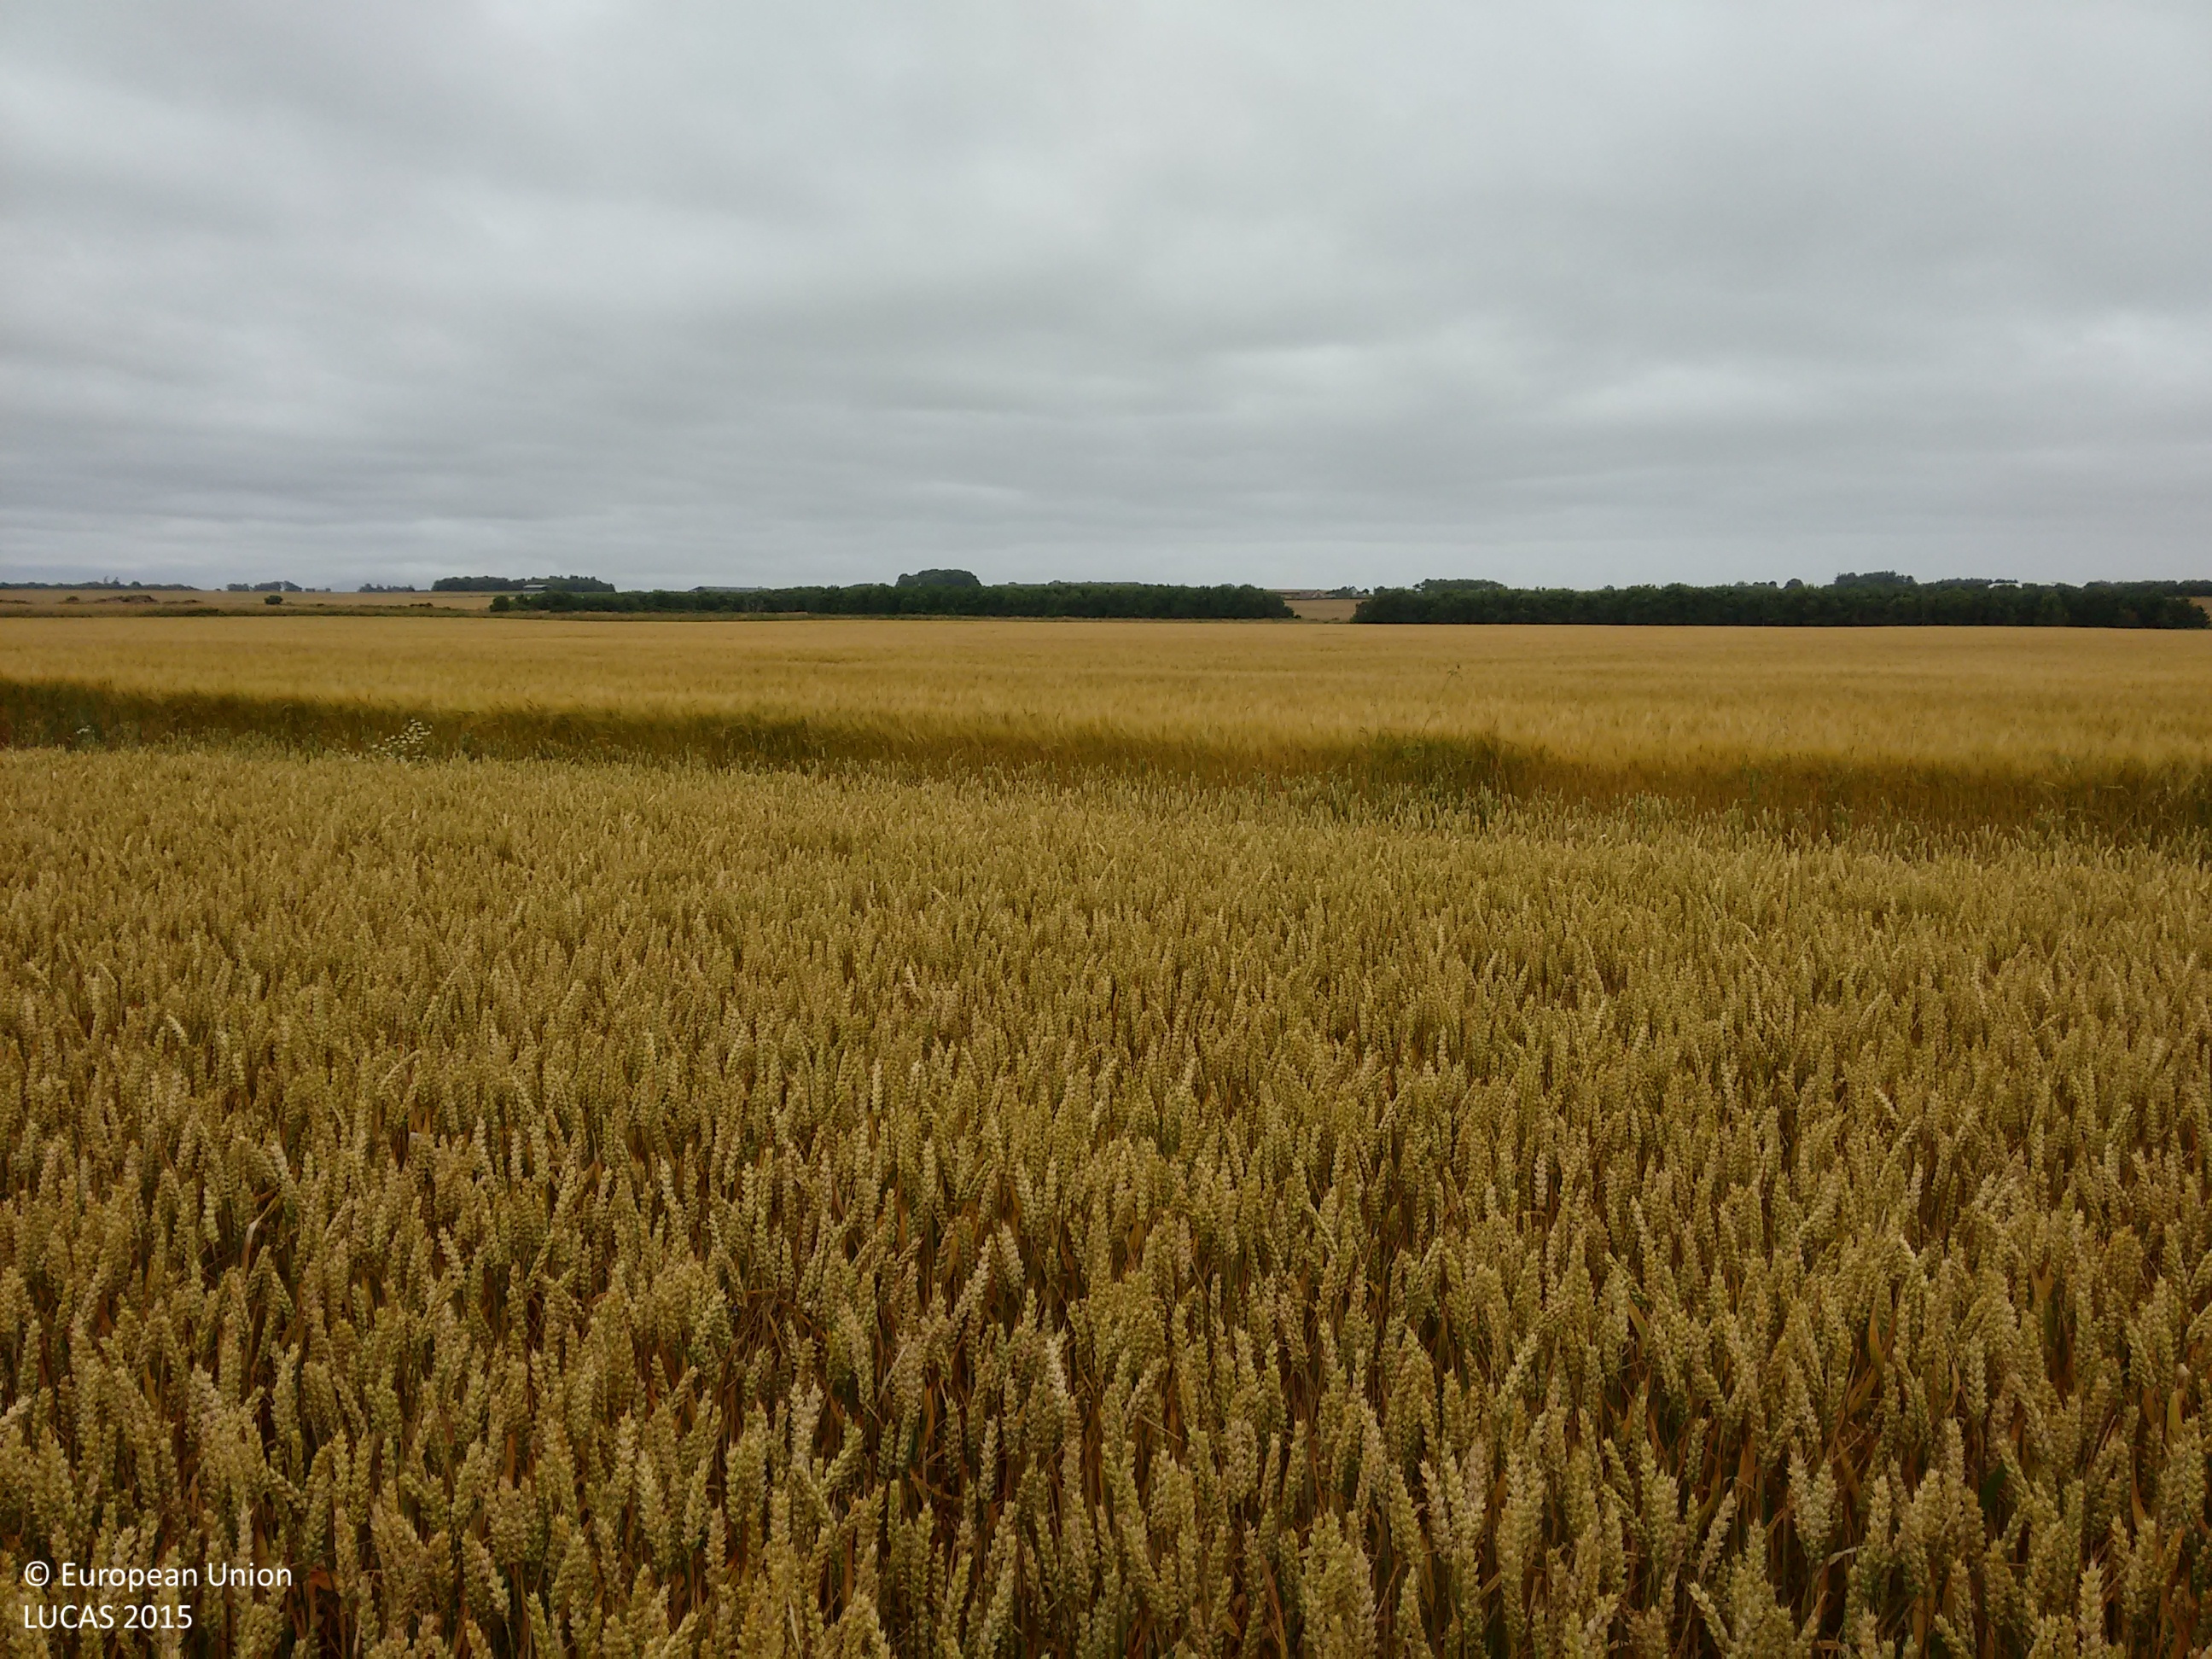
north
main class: Cropland
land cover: Common wheat
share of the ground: > 75 %
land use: Agriculture (excluding fallow land and kitchen gardens)
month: August
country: GB
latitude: 57.7655
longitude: -3.9112
